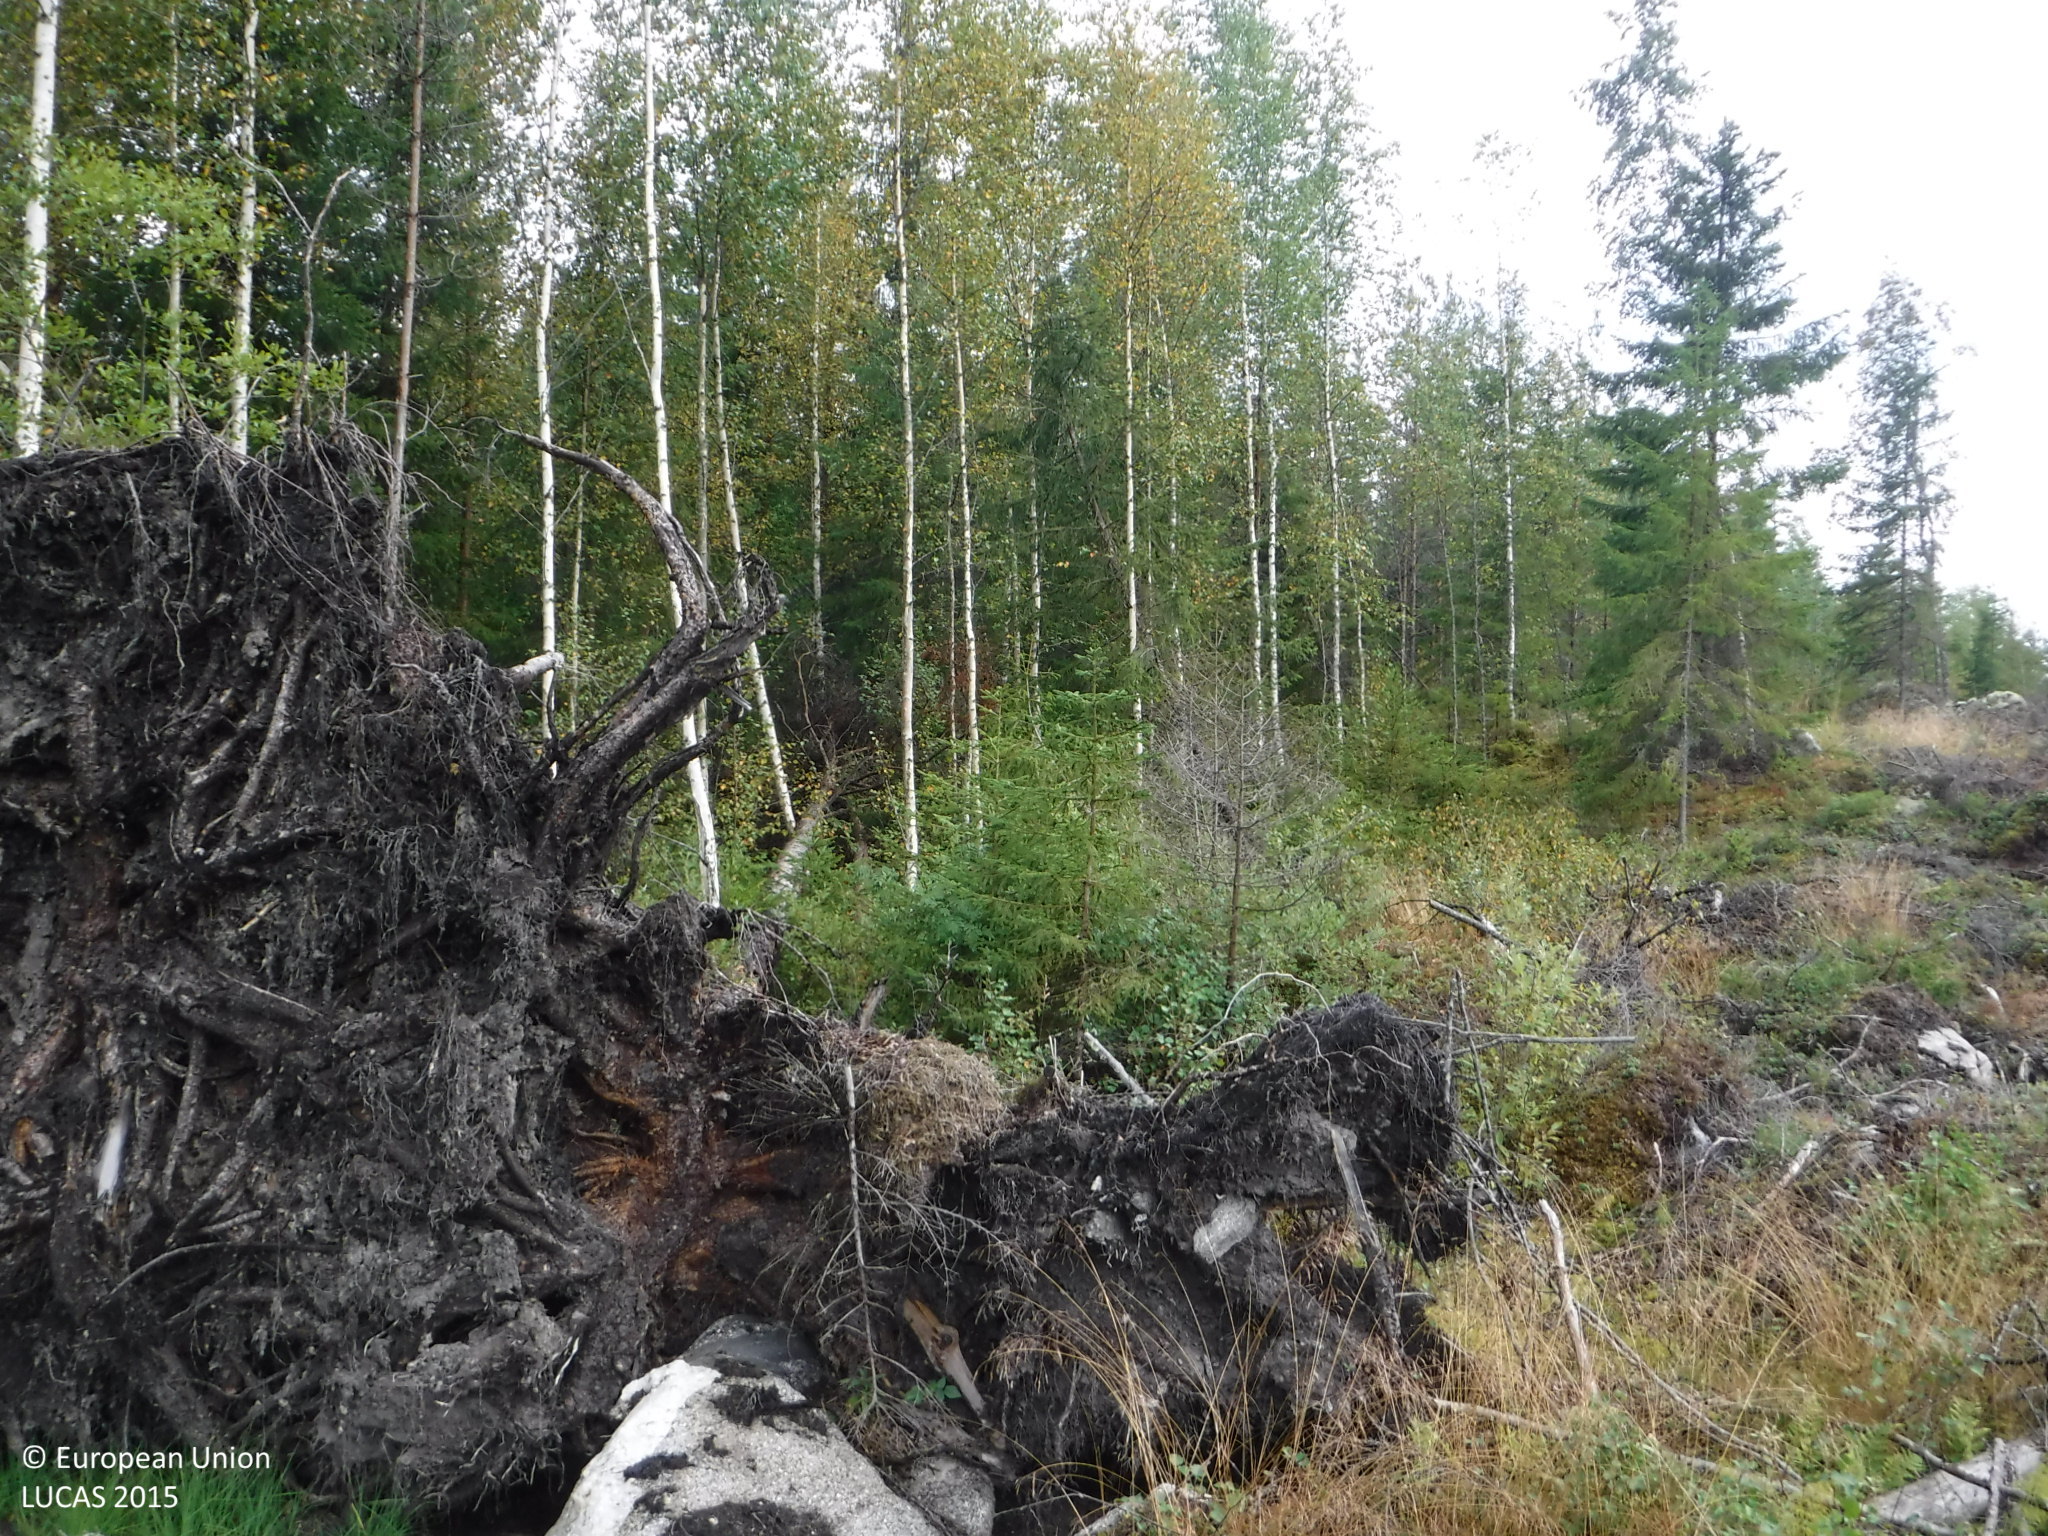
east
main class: Shrubland
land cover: Shrubland with sparse tree cover
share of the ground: 25 - 50 %
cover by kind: herbaceous plants 50 %, shrubs 30 %, unconsolidated bare surface 10 %, broadleaved forest trees 5 %, lichens and mosses 5 %
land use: Forestry
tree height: < 5 m
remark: Clear cut
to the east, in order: Shrubland with sparse tree cover; Pine dominated mixed woodland; Other coniferous woodland; Pine dominated coniferous woodland
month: September
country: FI
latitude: 61.3270
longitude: 22.6405
